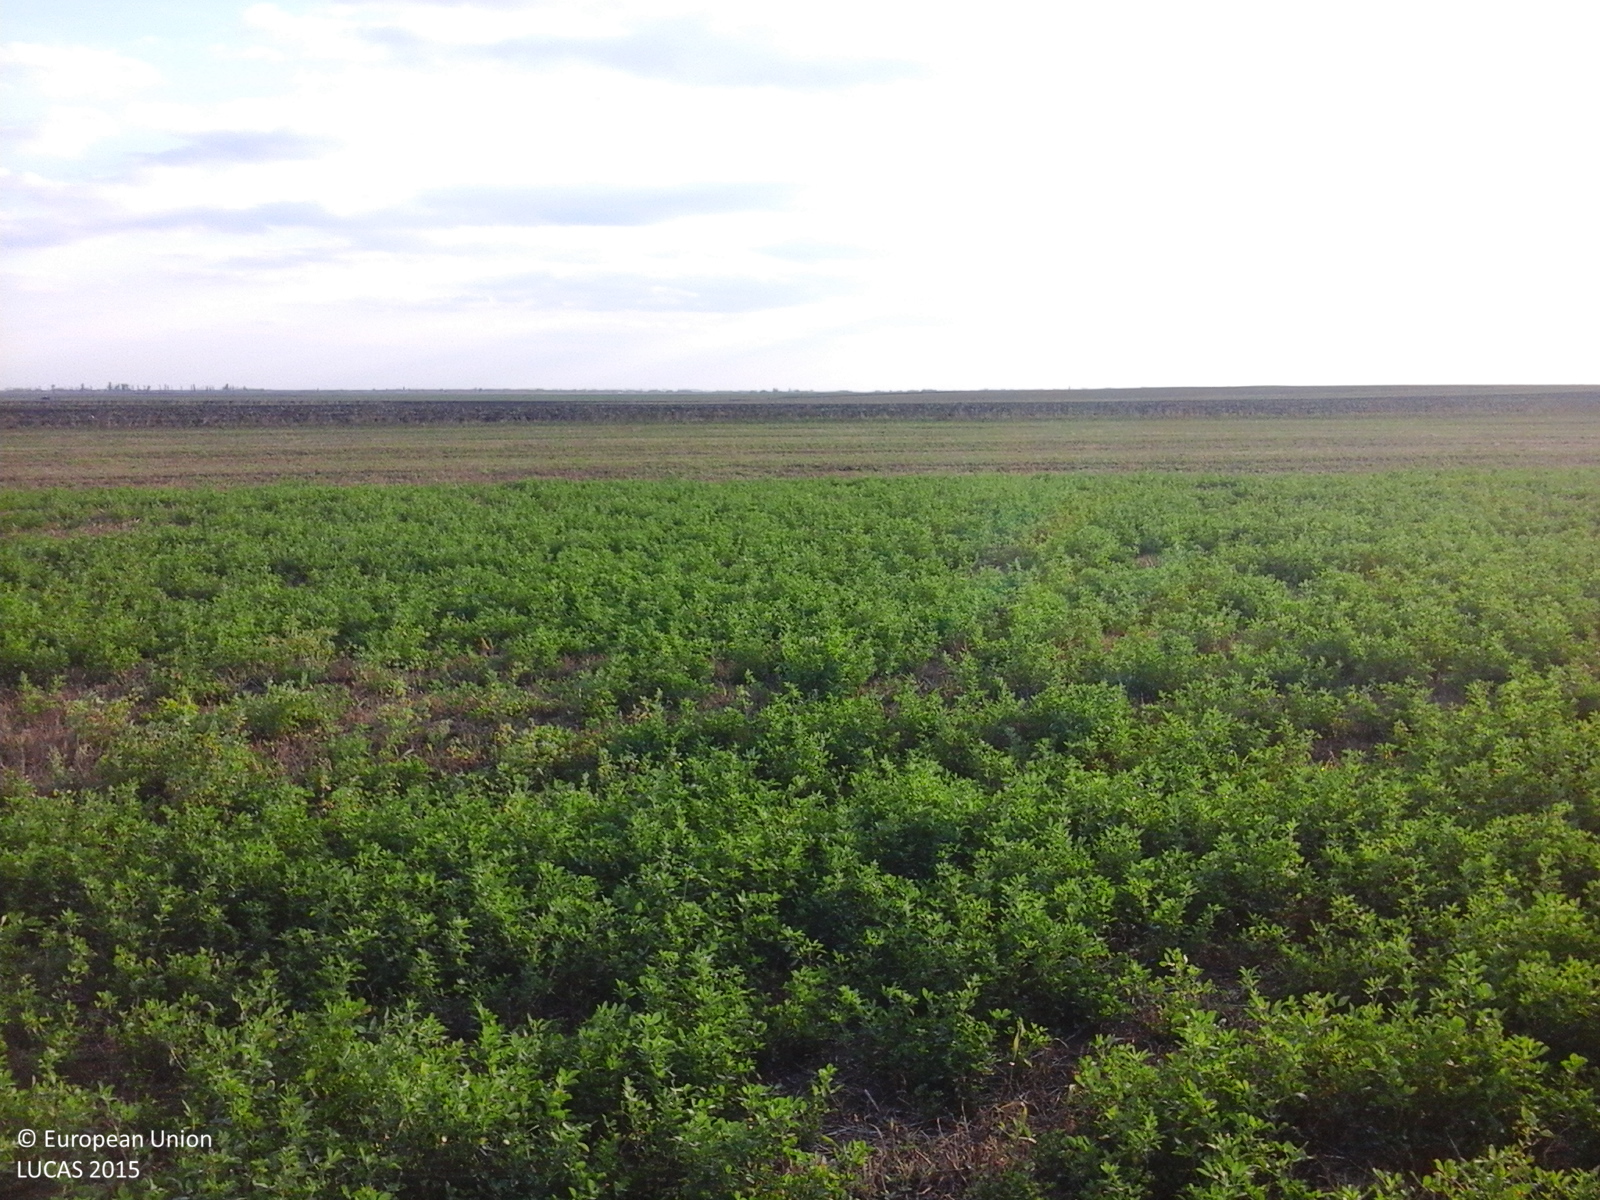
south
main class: Cropland
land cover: Lucerne
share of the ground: > 75 %
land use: Agriculture (excluding fallow land and kitchen gardens)
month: October
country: RO
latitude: 45.3201
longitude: 27.0417
